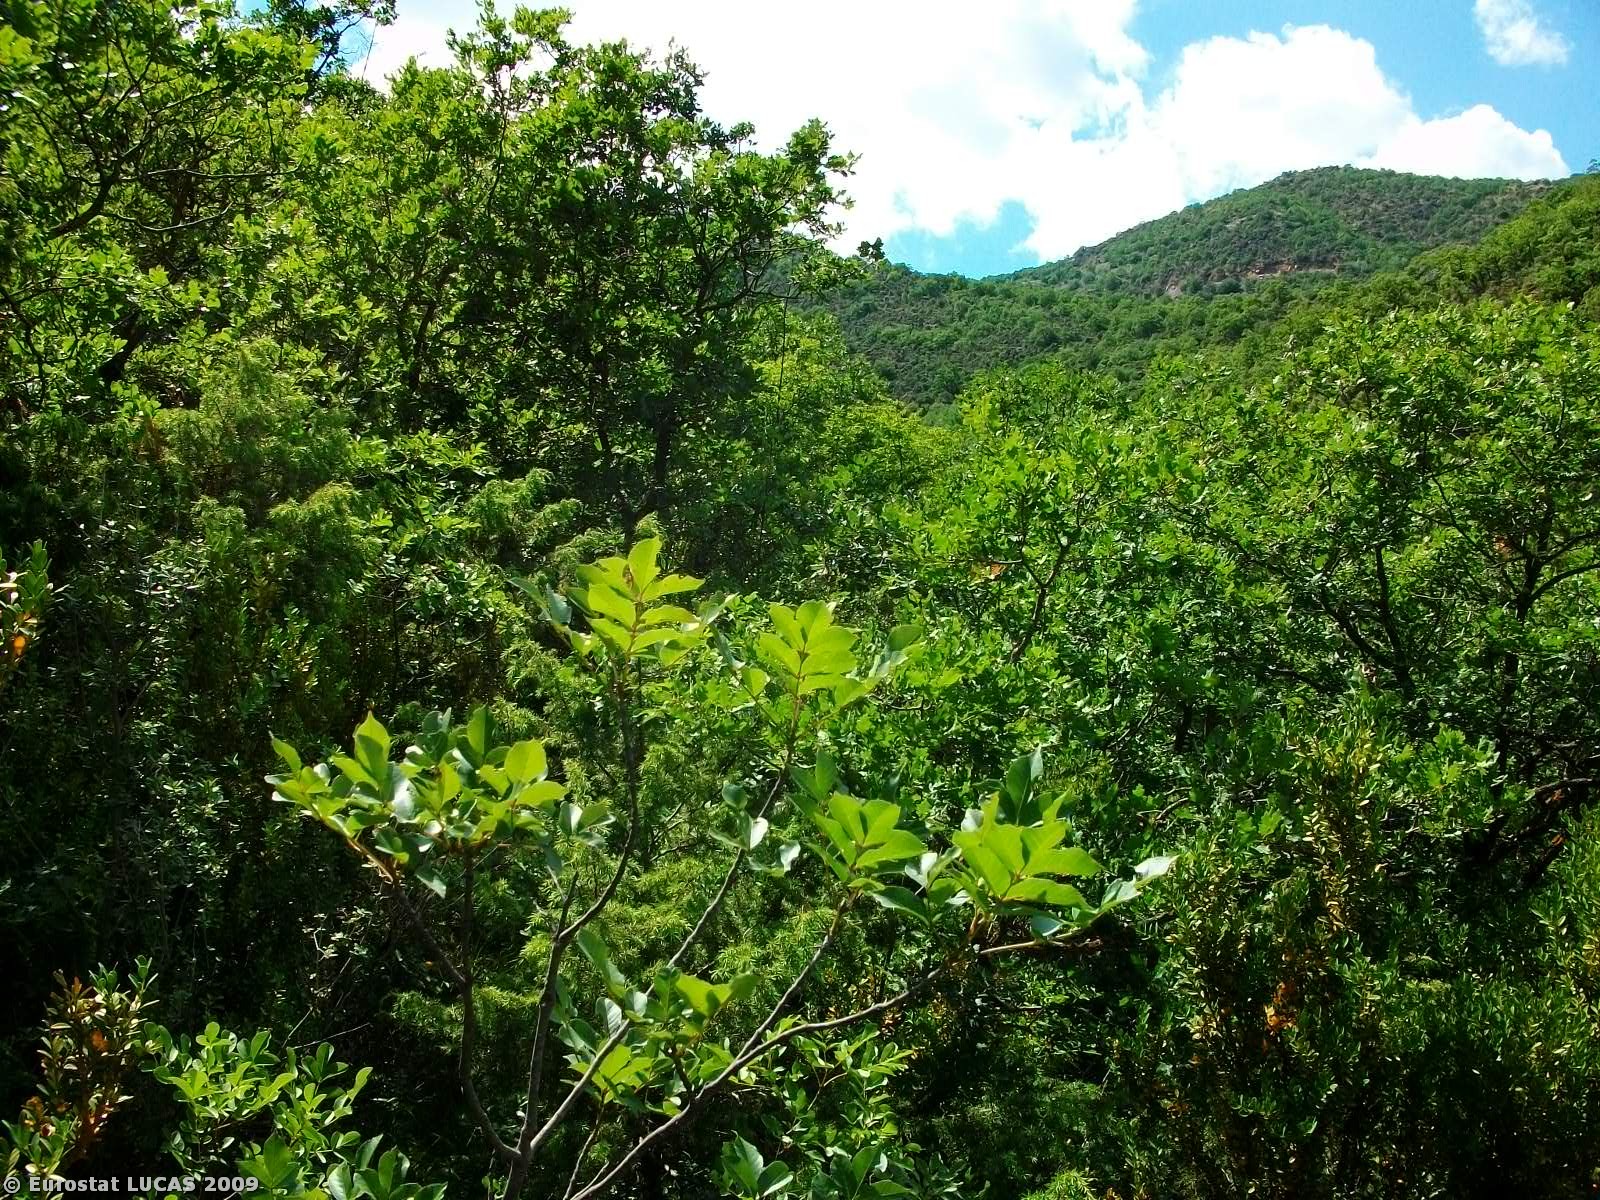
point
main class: Woodland
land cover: Broadleaved woodland
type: thermophilous deciduous forest
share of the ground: > 75 %
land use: Forestry
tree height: > 5 m
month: June
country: GR
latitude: 40.0495
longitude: 21.7693
